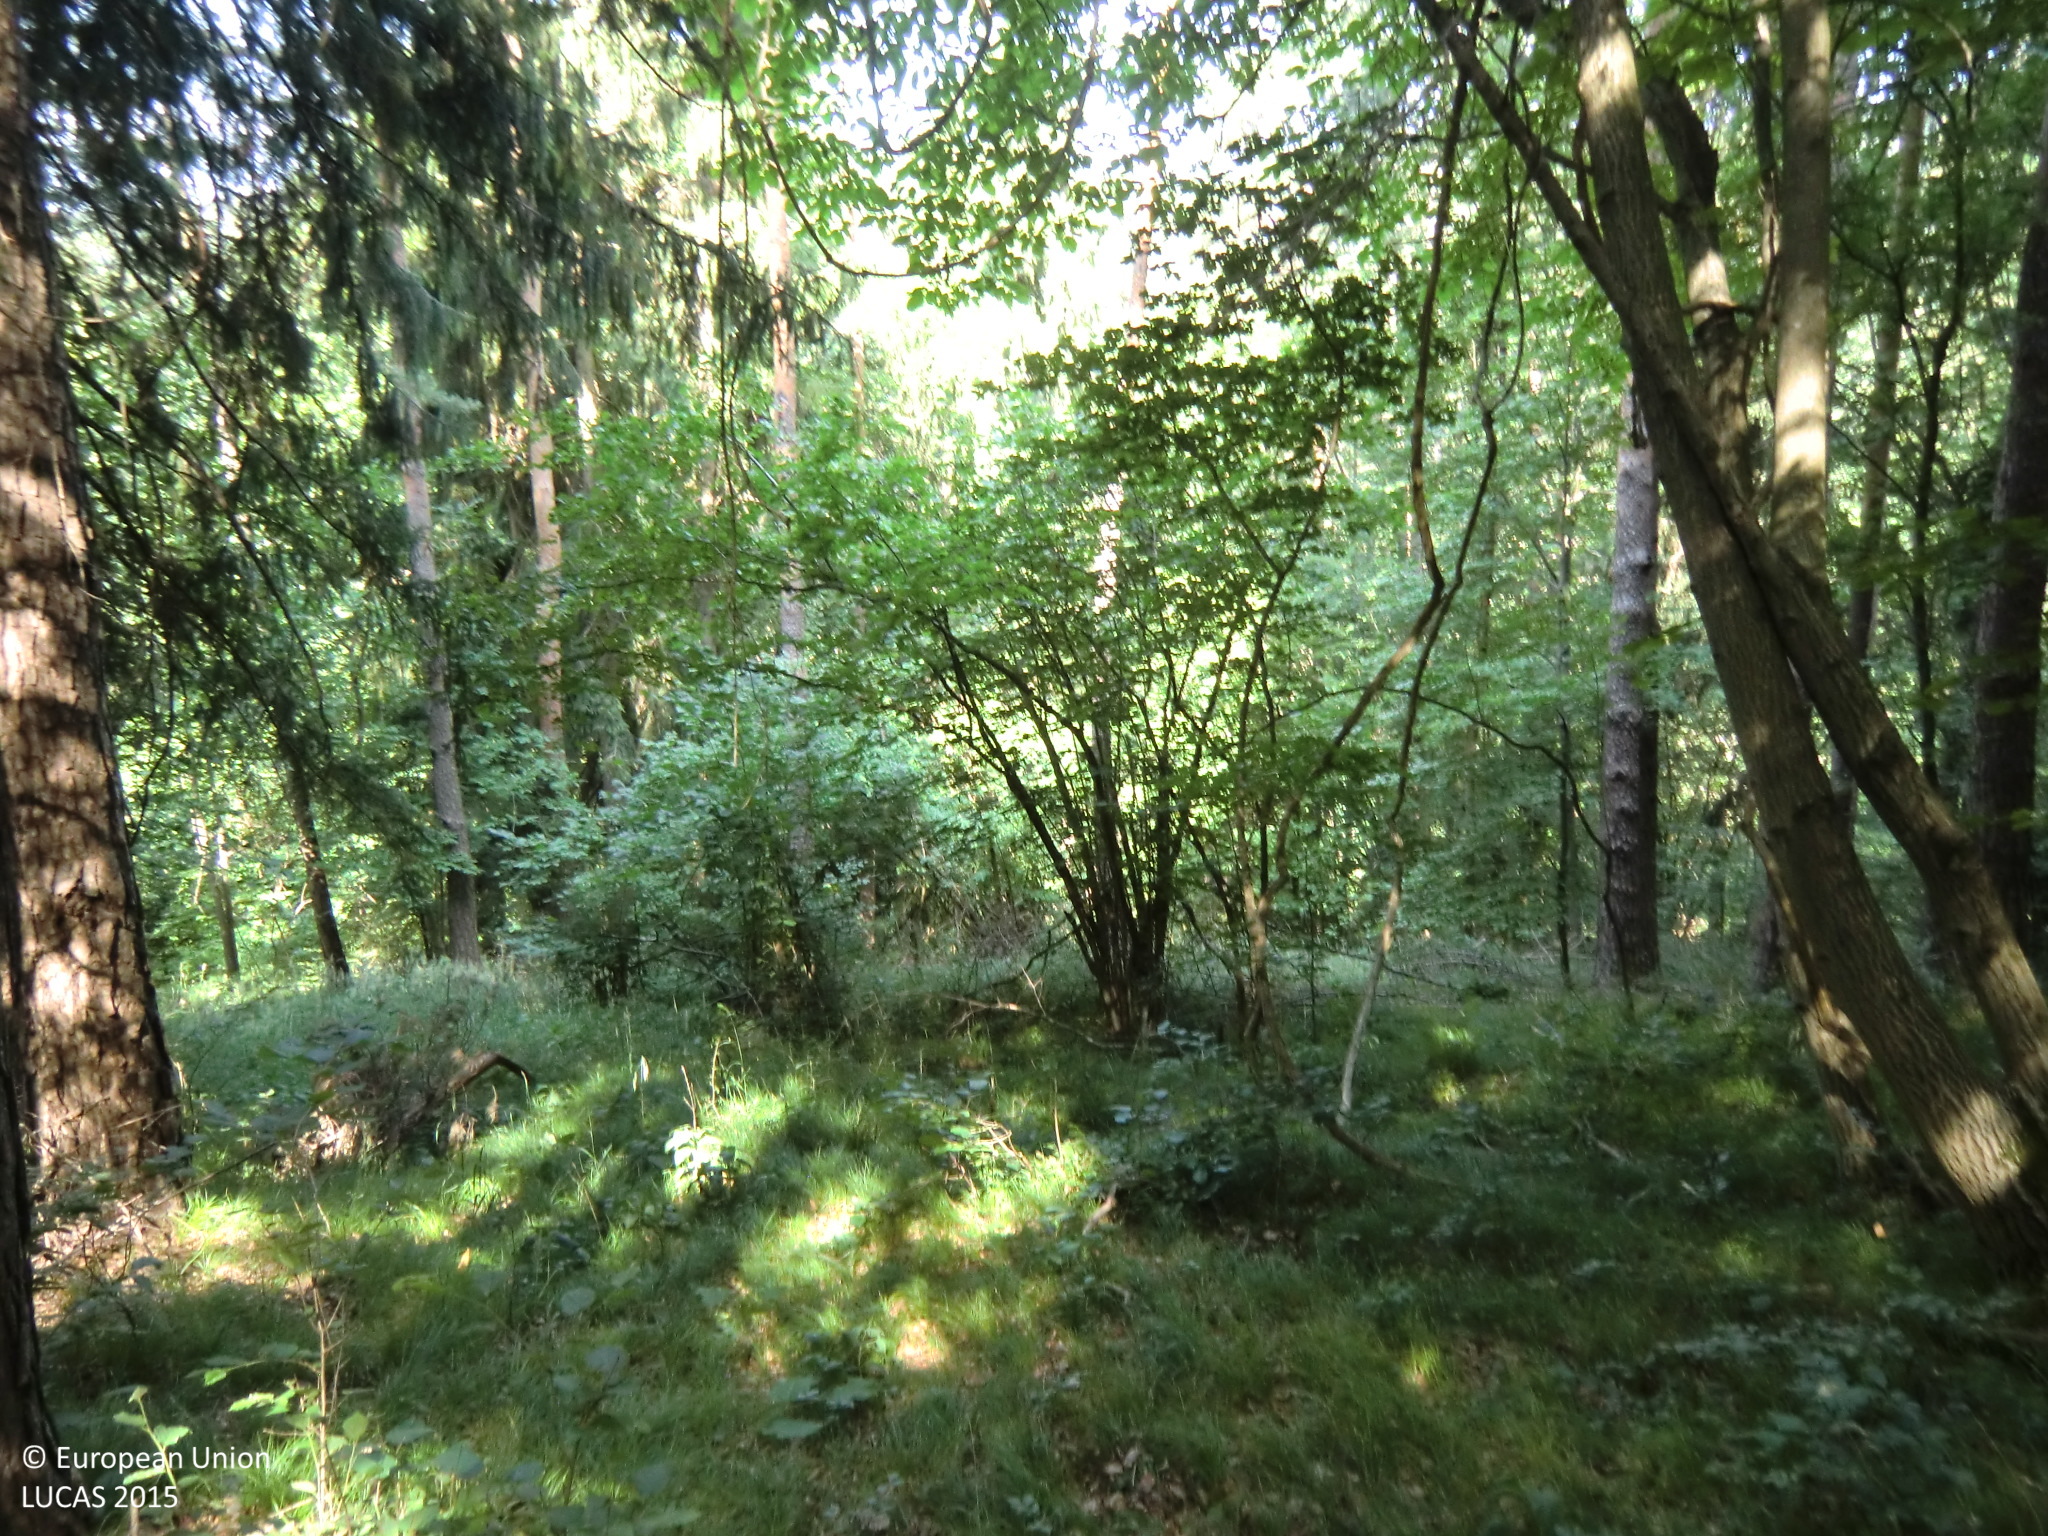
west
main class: Woodland
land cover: Other mixed woodland
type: hemiboreal forest and nemoral coniferous forest and mixed broadleaved-coniferous forest
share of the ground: > 75 %
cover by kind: coniferous forest trees 45 %, broadleaved forest trees 40 %, herbaceous plants 10 %, unconsolidated bare surface 5 %
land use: Forestry
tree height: > 5 m
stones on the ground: < 10 %
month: July
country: AT
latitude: 47.1522
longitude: 15.4205
